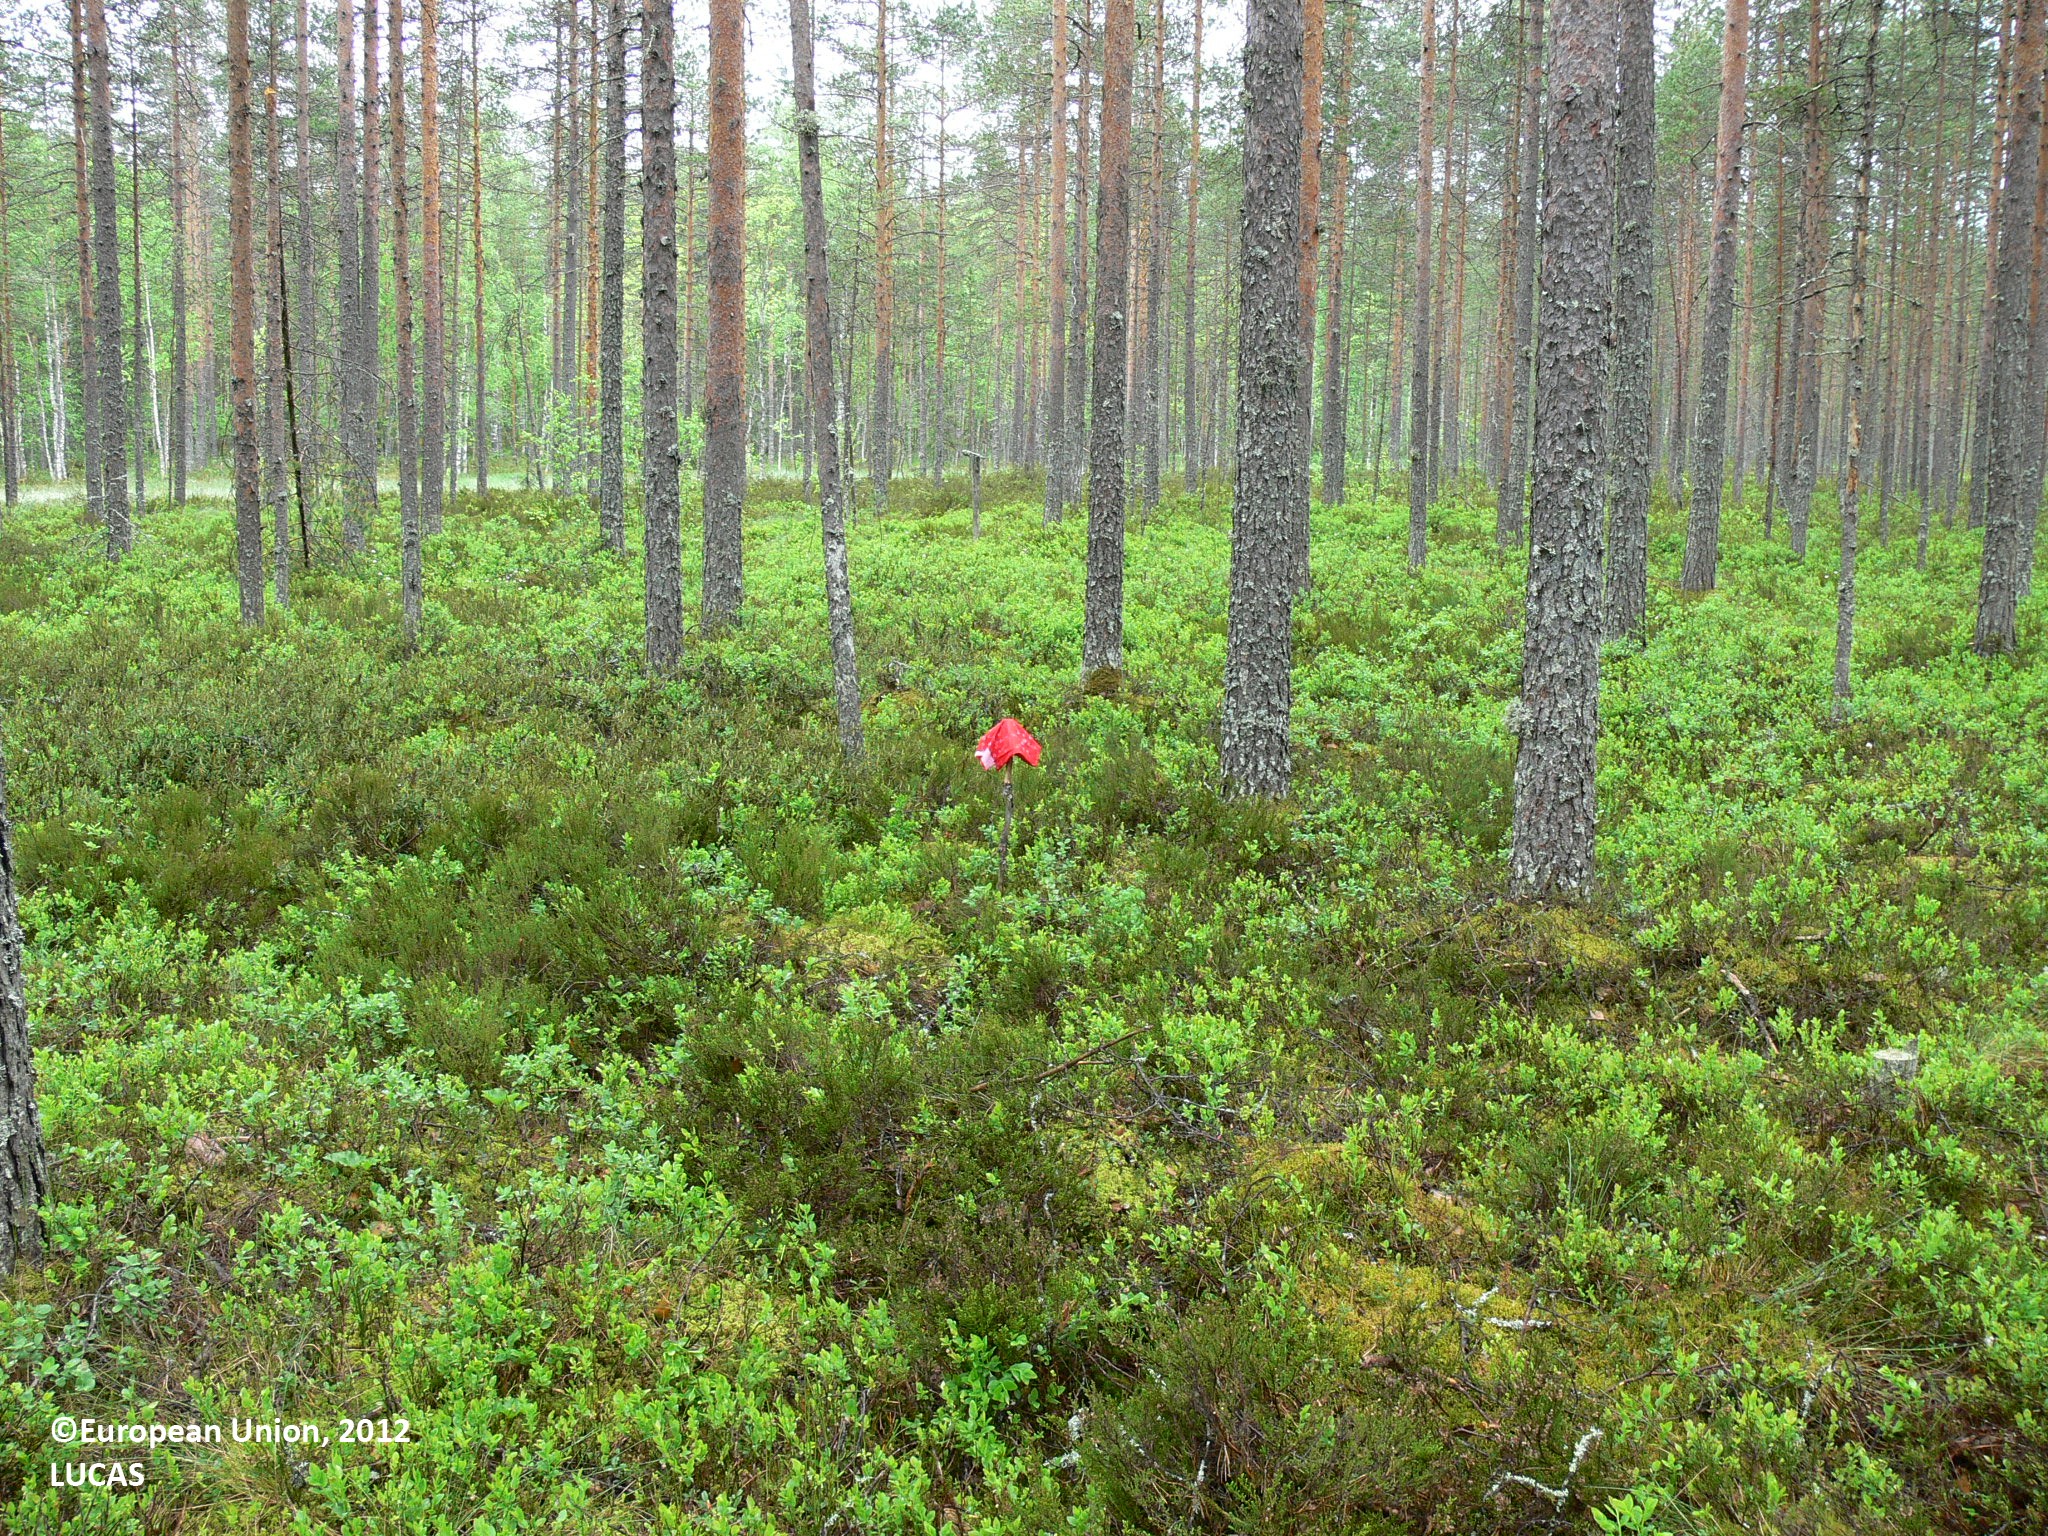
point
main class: Woodland
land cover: Pine dominated coniferous woodland
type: boreal forest
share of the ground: > 75 %
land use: Forestry
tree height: > 5 m
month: June
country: FI
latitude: 62.4873
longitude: 30.2380
